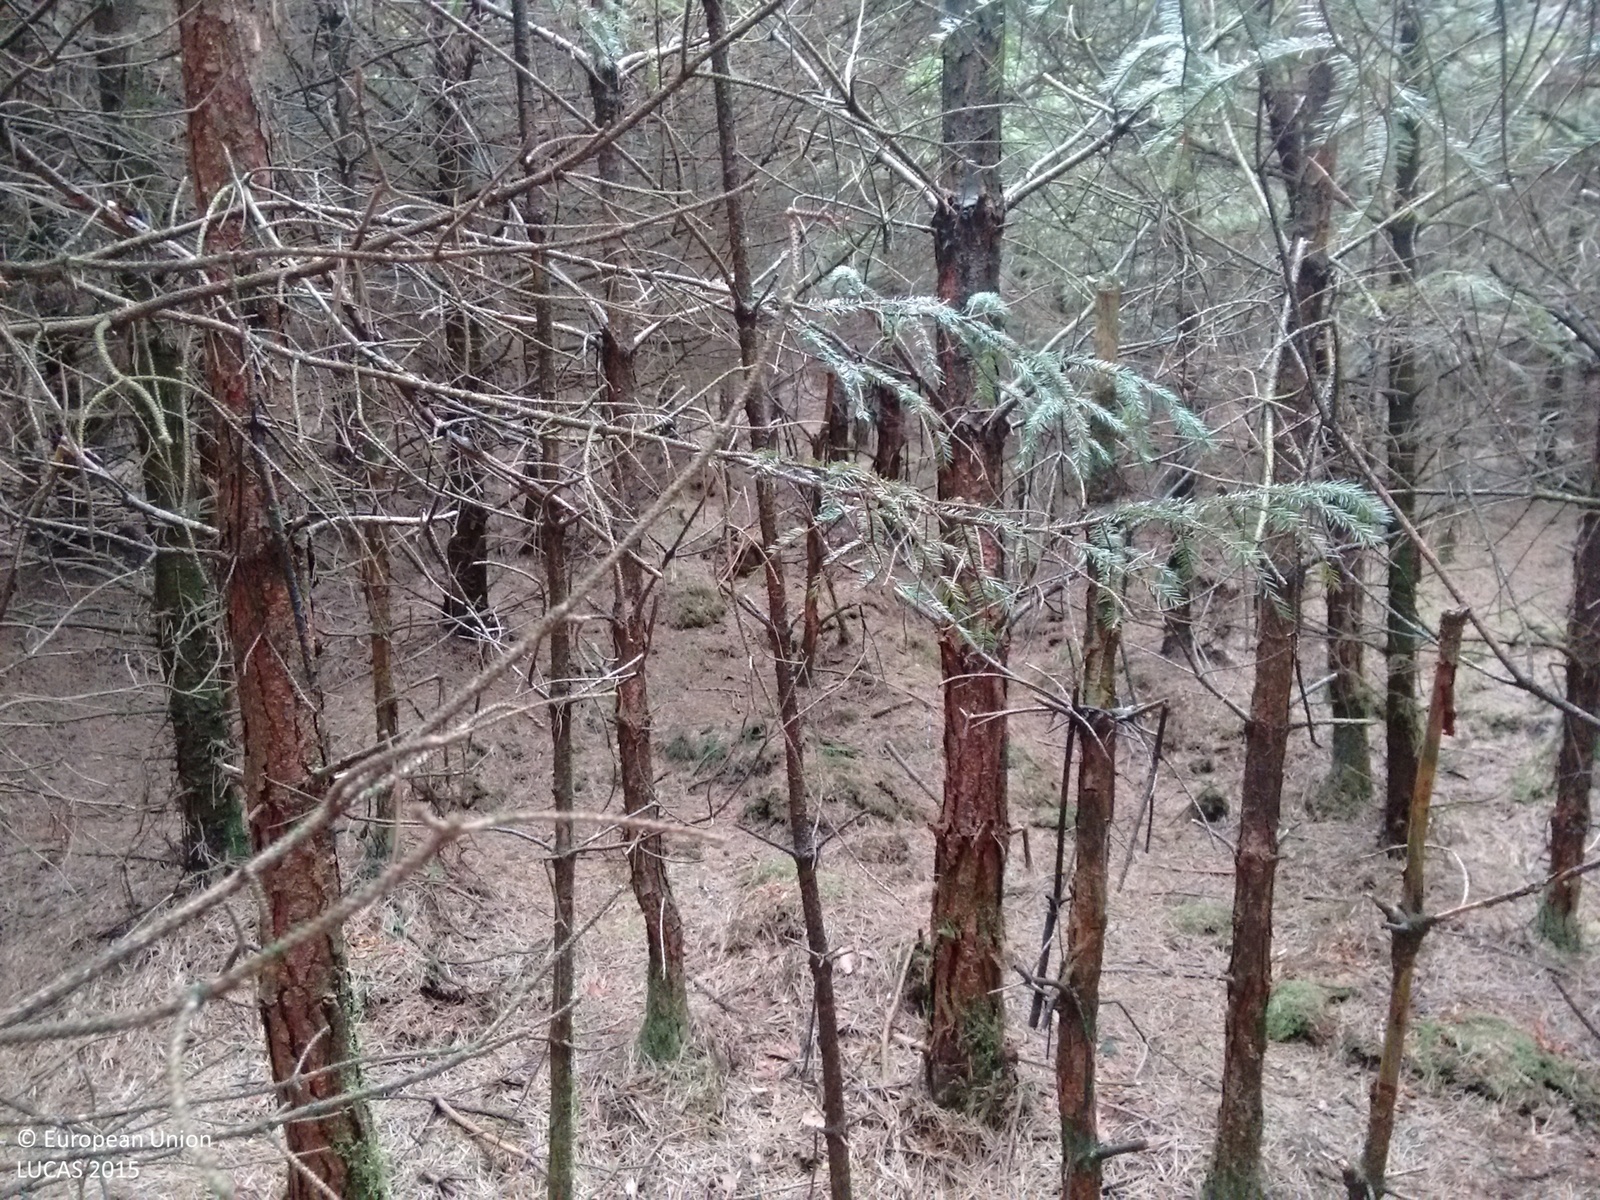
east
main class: Woodland
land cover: Pine dominated coniferous woodland
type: exotic forest
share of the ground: > 75 %
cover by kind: coniferous forest trees 80 %, broadleaved forest trees 20 %
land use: Forestry
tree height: > 5 m
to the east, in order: Pine dominated coniferous woodland; Lines of trees; Paved roads, cycling and walking lanes; Pine dominated coniferous woodland
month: June
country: GB
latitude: 54.3107
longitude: -0.8455
